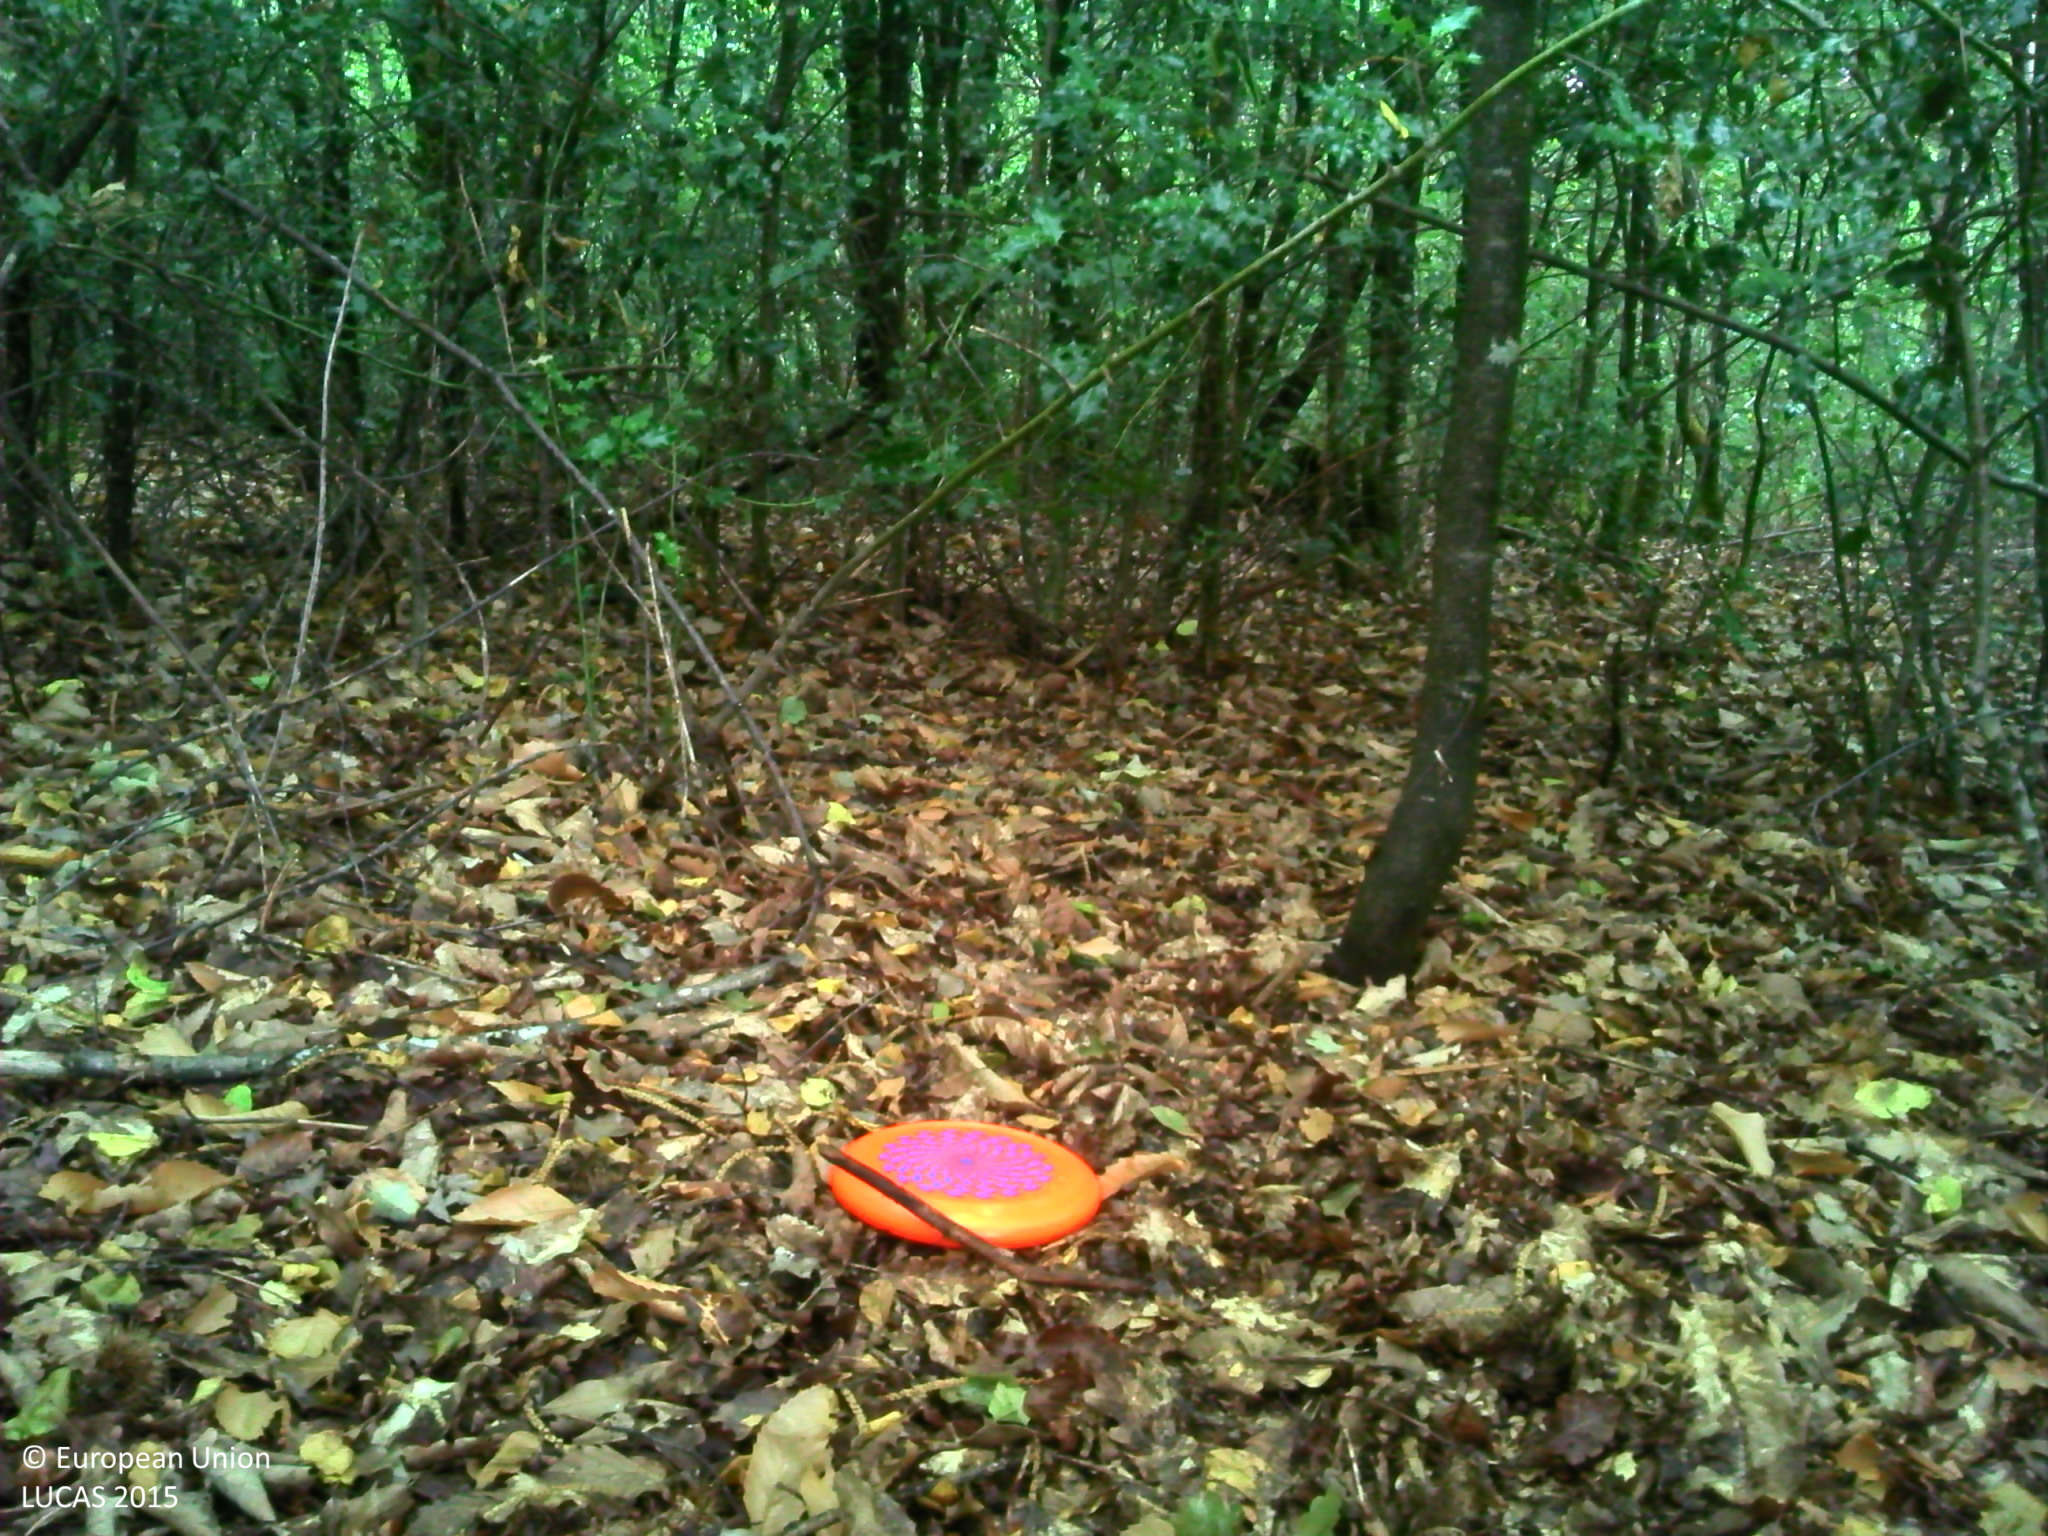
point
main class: Woodland
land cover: Broadleaved woodland
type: boreal forest
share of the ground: > 75 %
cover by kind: broadleaved forest trees 60 %, unconsolidated bare surface 30 %, herbaceous plants 10 %
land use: Forestry
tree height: > 5 m
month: July
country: FR
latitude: 45.6971
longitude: 1.6331
